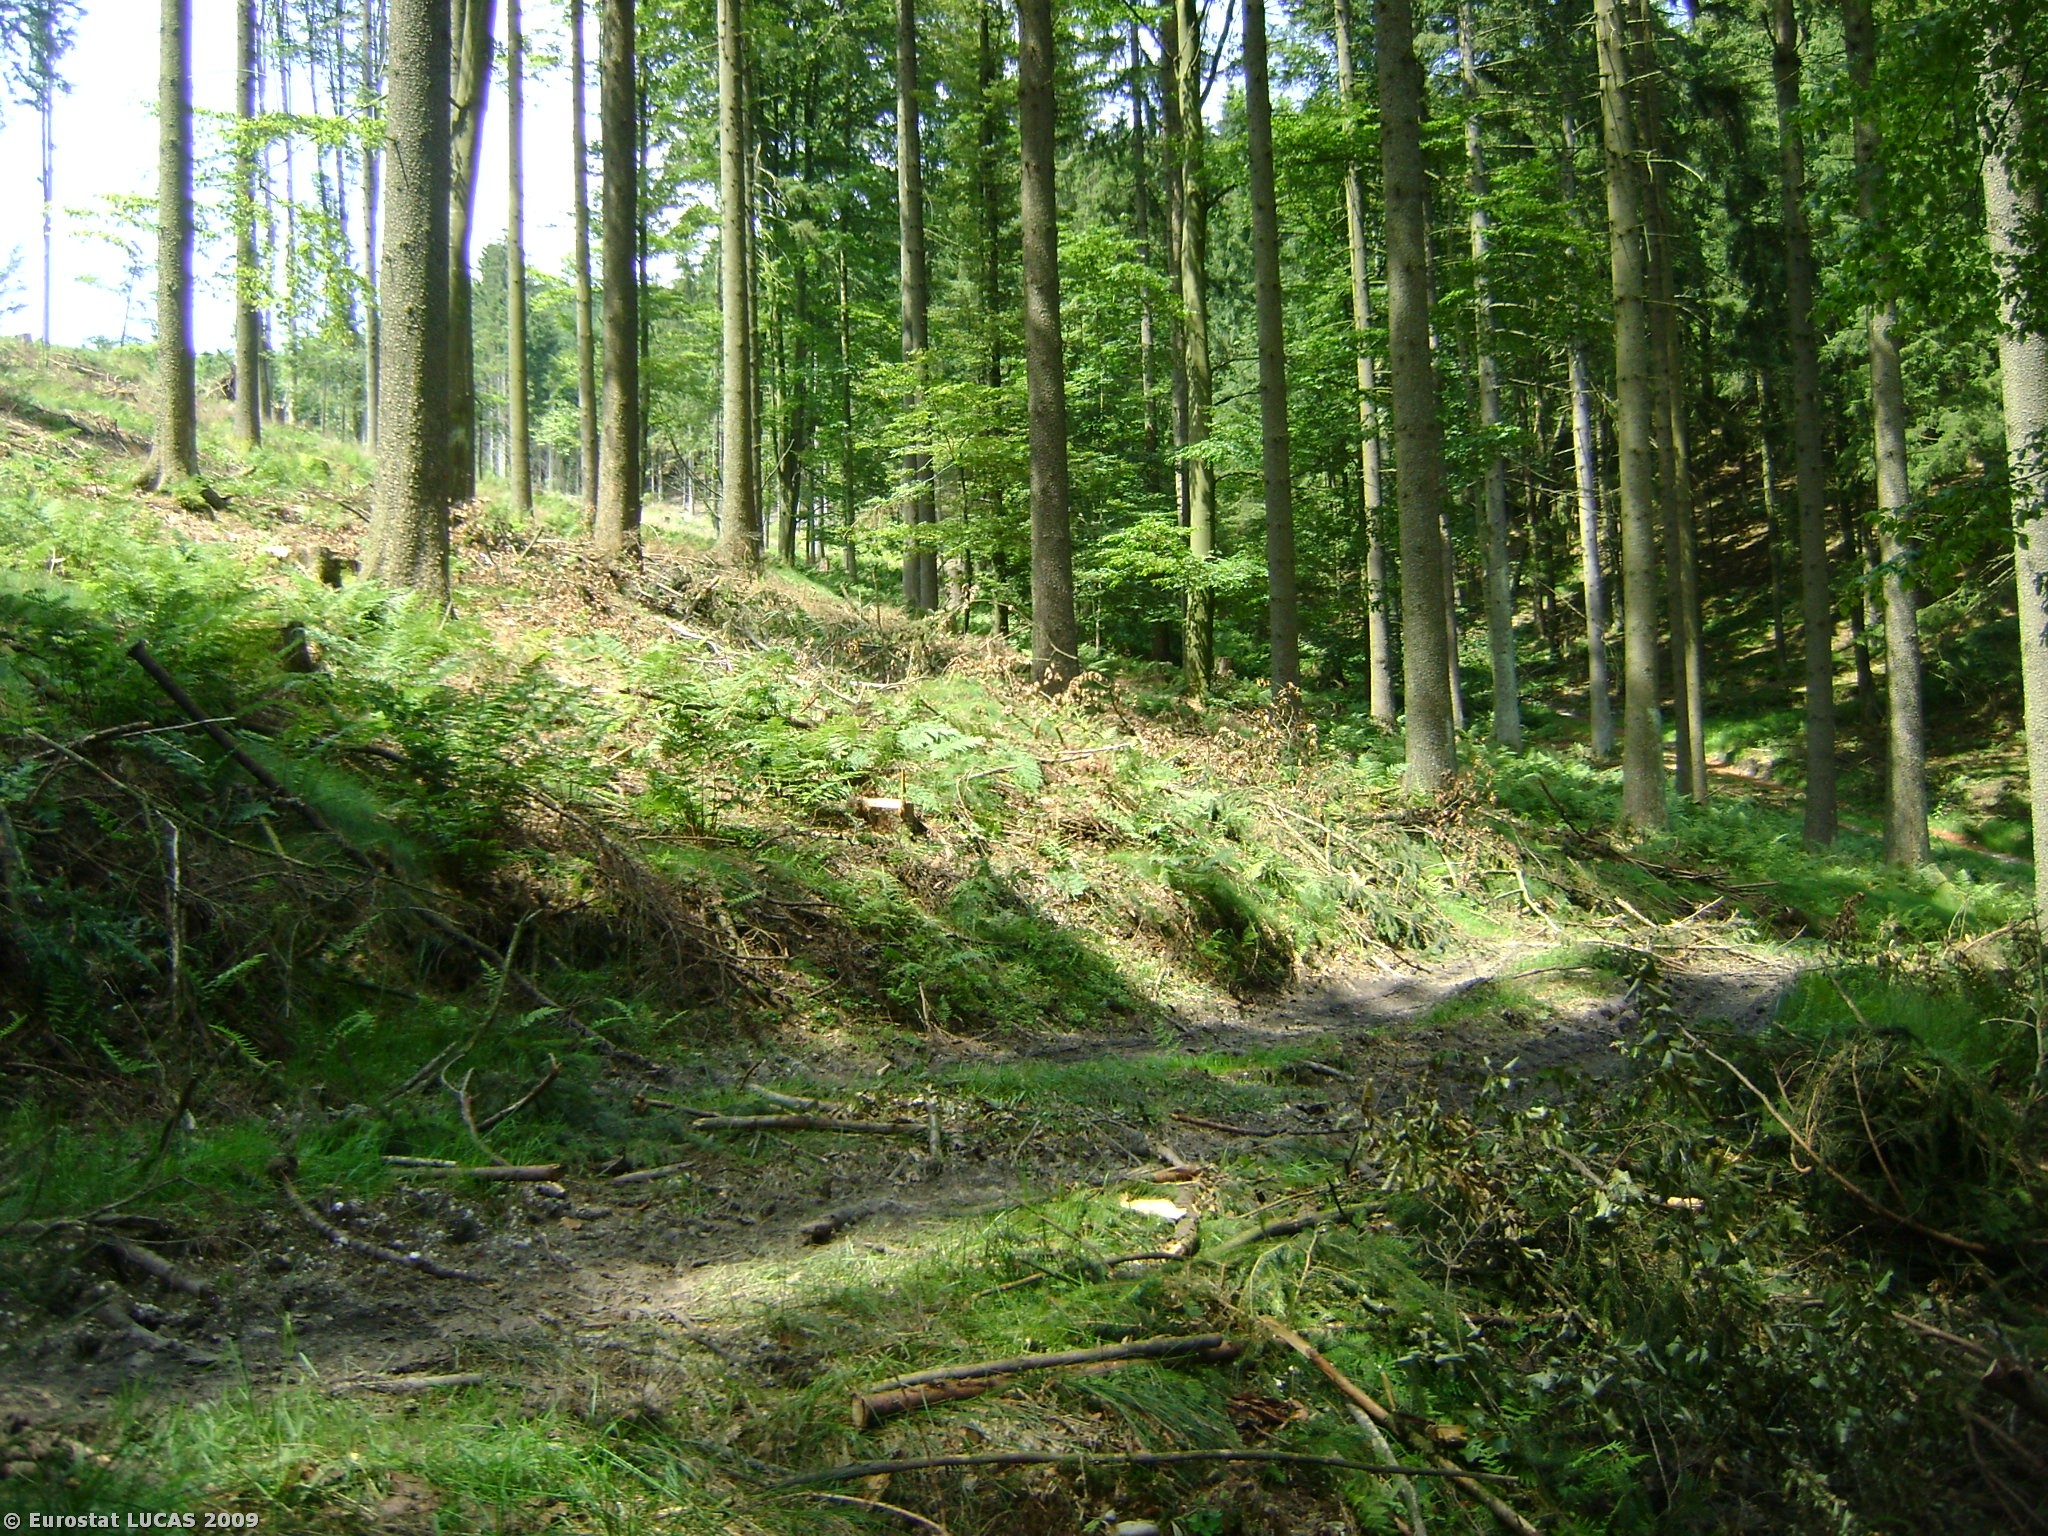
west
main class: Woodland
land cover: Mixed woodland
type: hemiboreal forest and nemoral coniferous forest and mixed broadleaved-coniferous forest
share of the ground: > 75 %
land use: Forestry
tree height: > 5 m
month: July
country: AT
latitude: 48.0950
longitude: 13.5305
